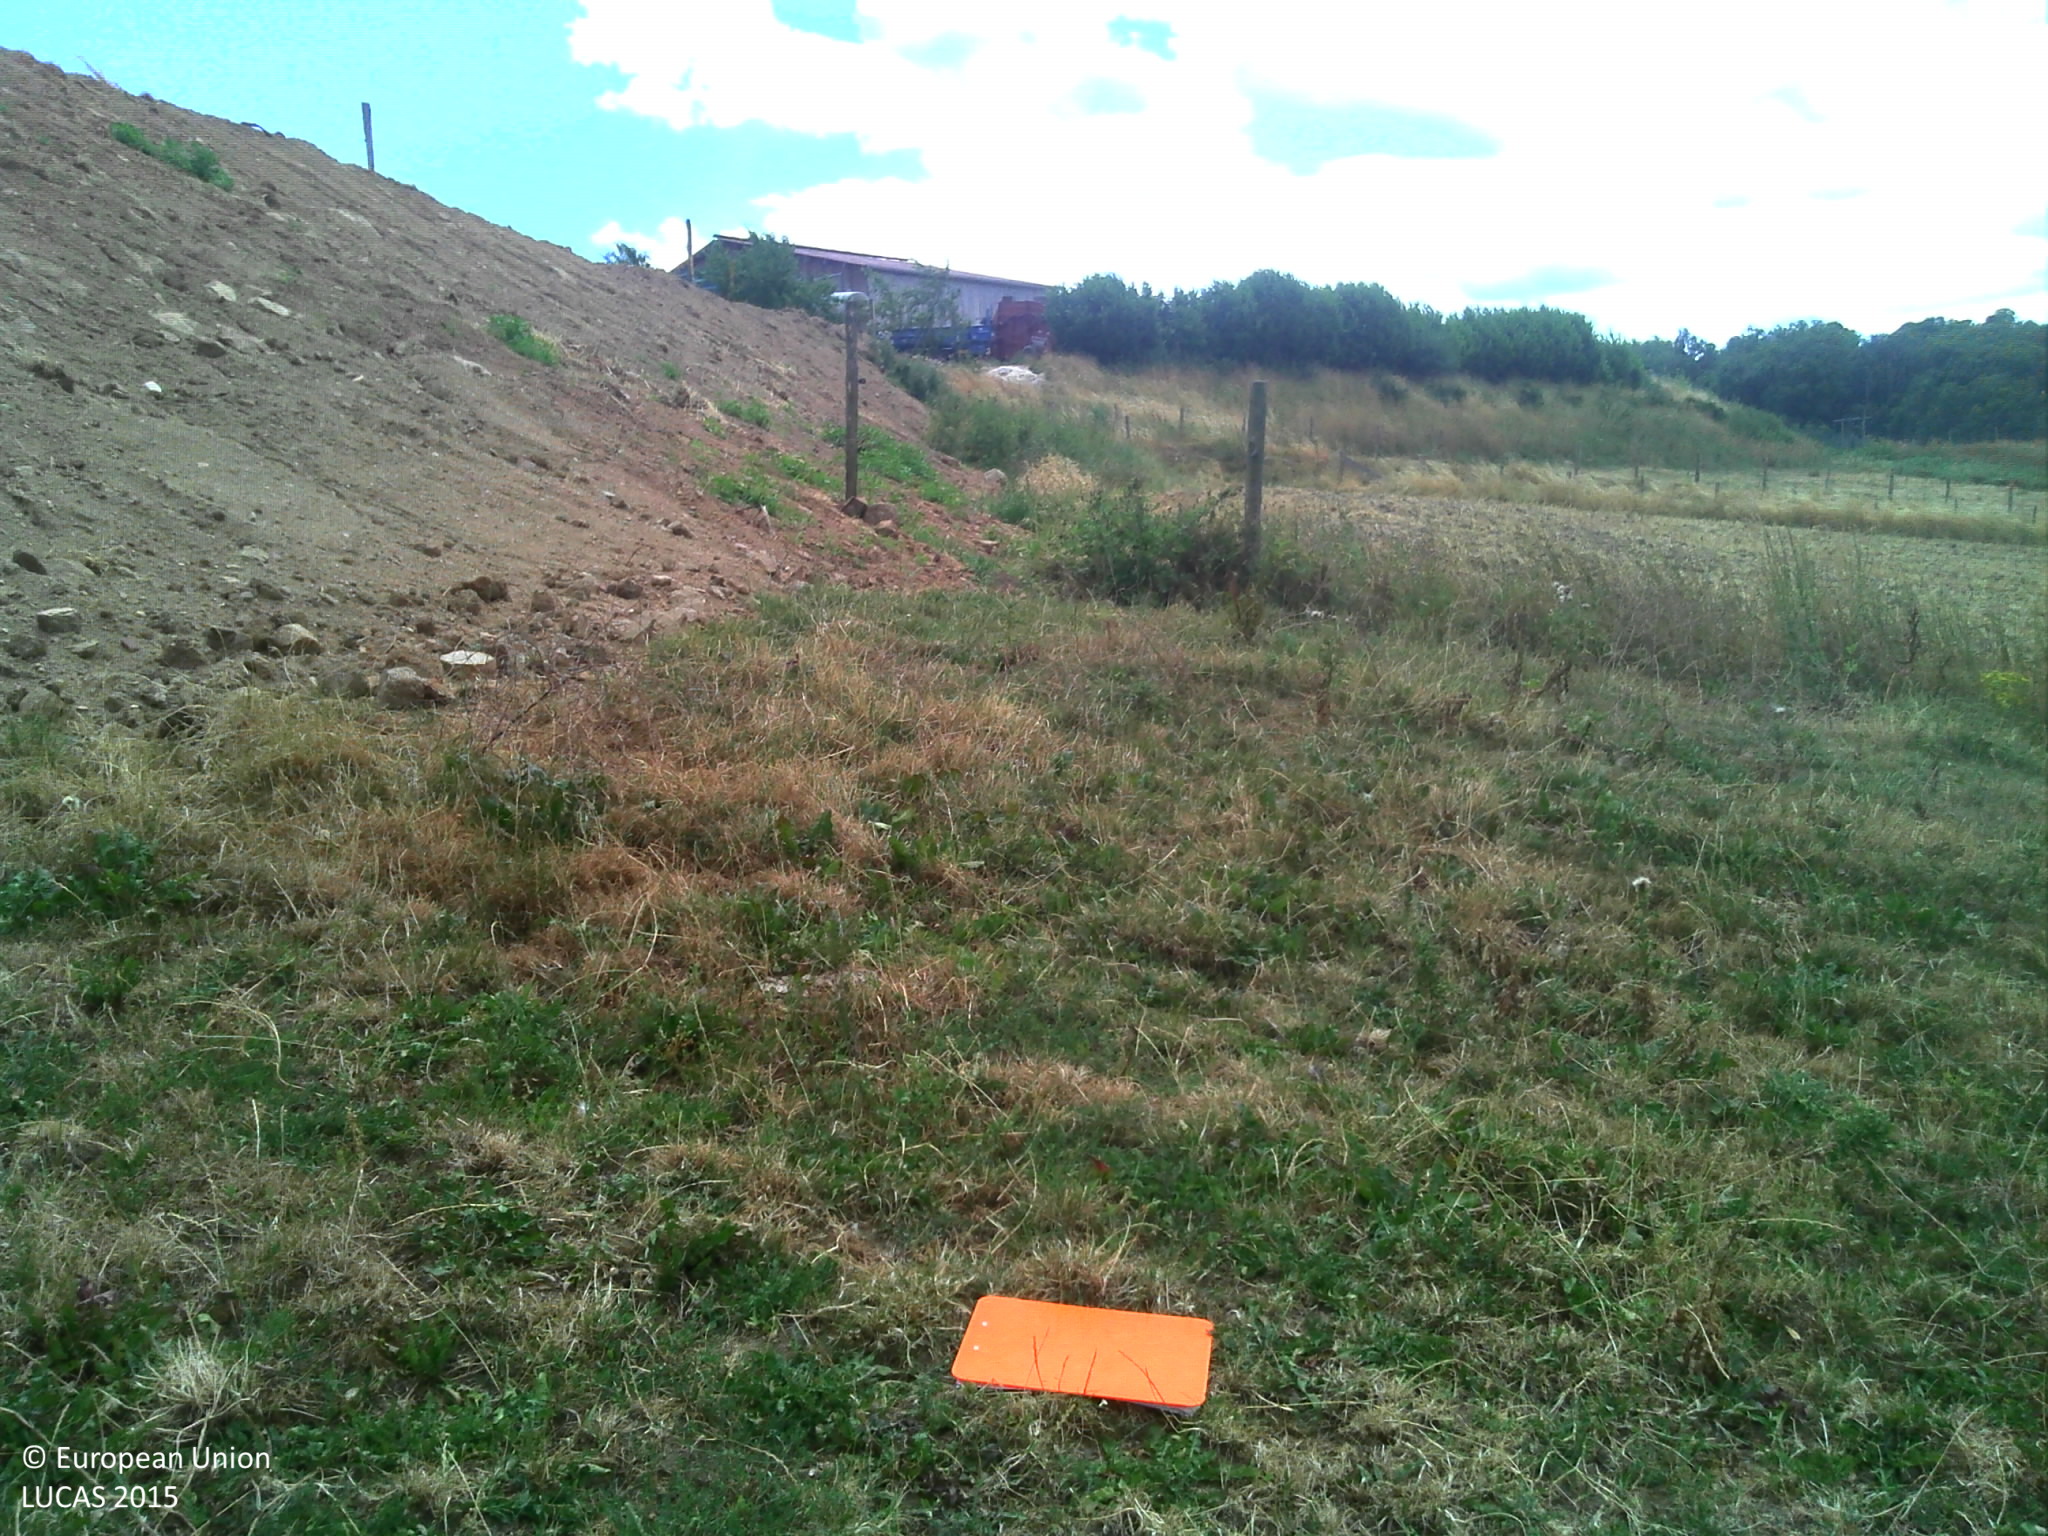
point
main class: Grassland
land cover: Grassland without tree/shrub cover
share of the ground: > 75 %
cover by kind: herbaceous plants 100 %
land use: Agriculture (excluding fallow land and kitchen gardens)
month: July
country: FR
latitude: 45.7564
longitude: 4.4621
